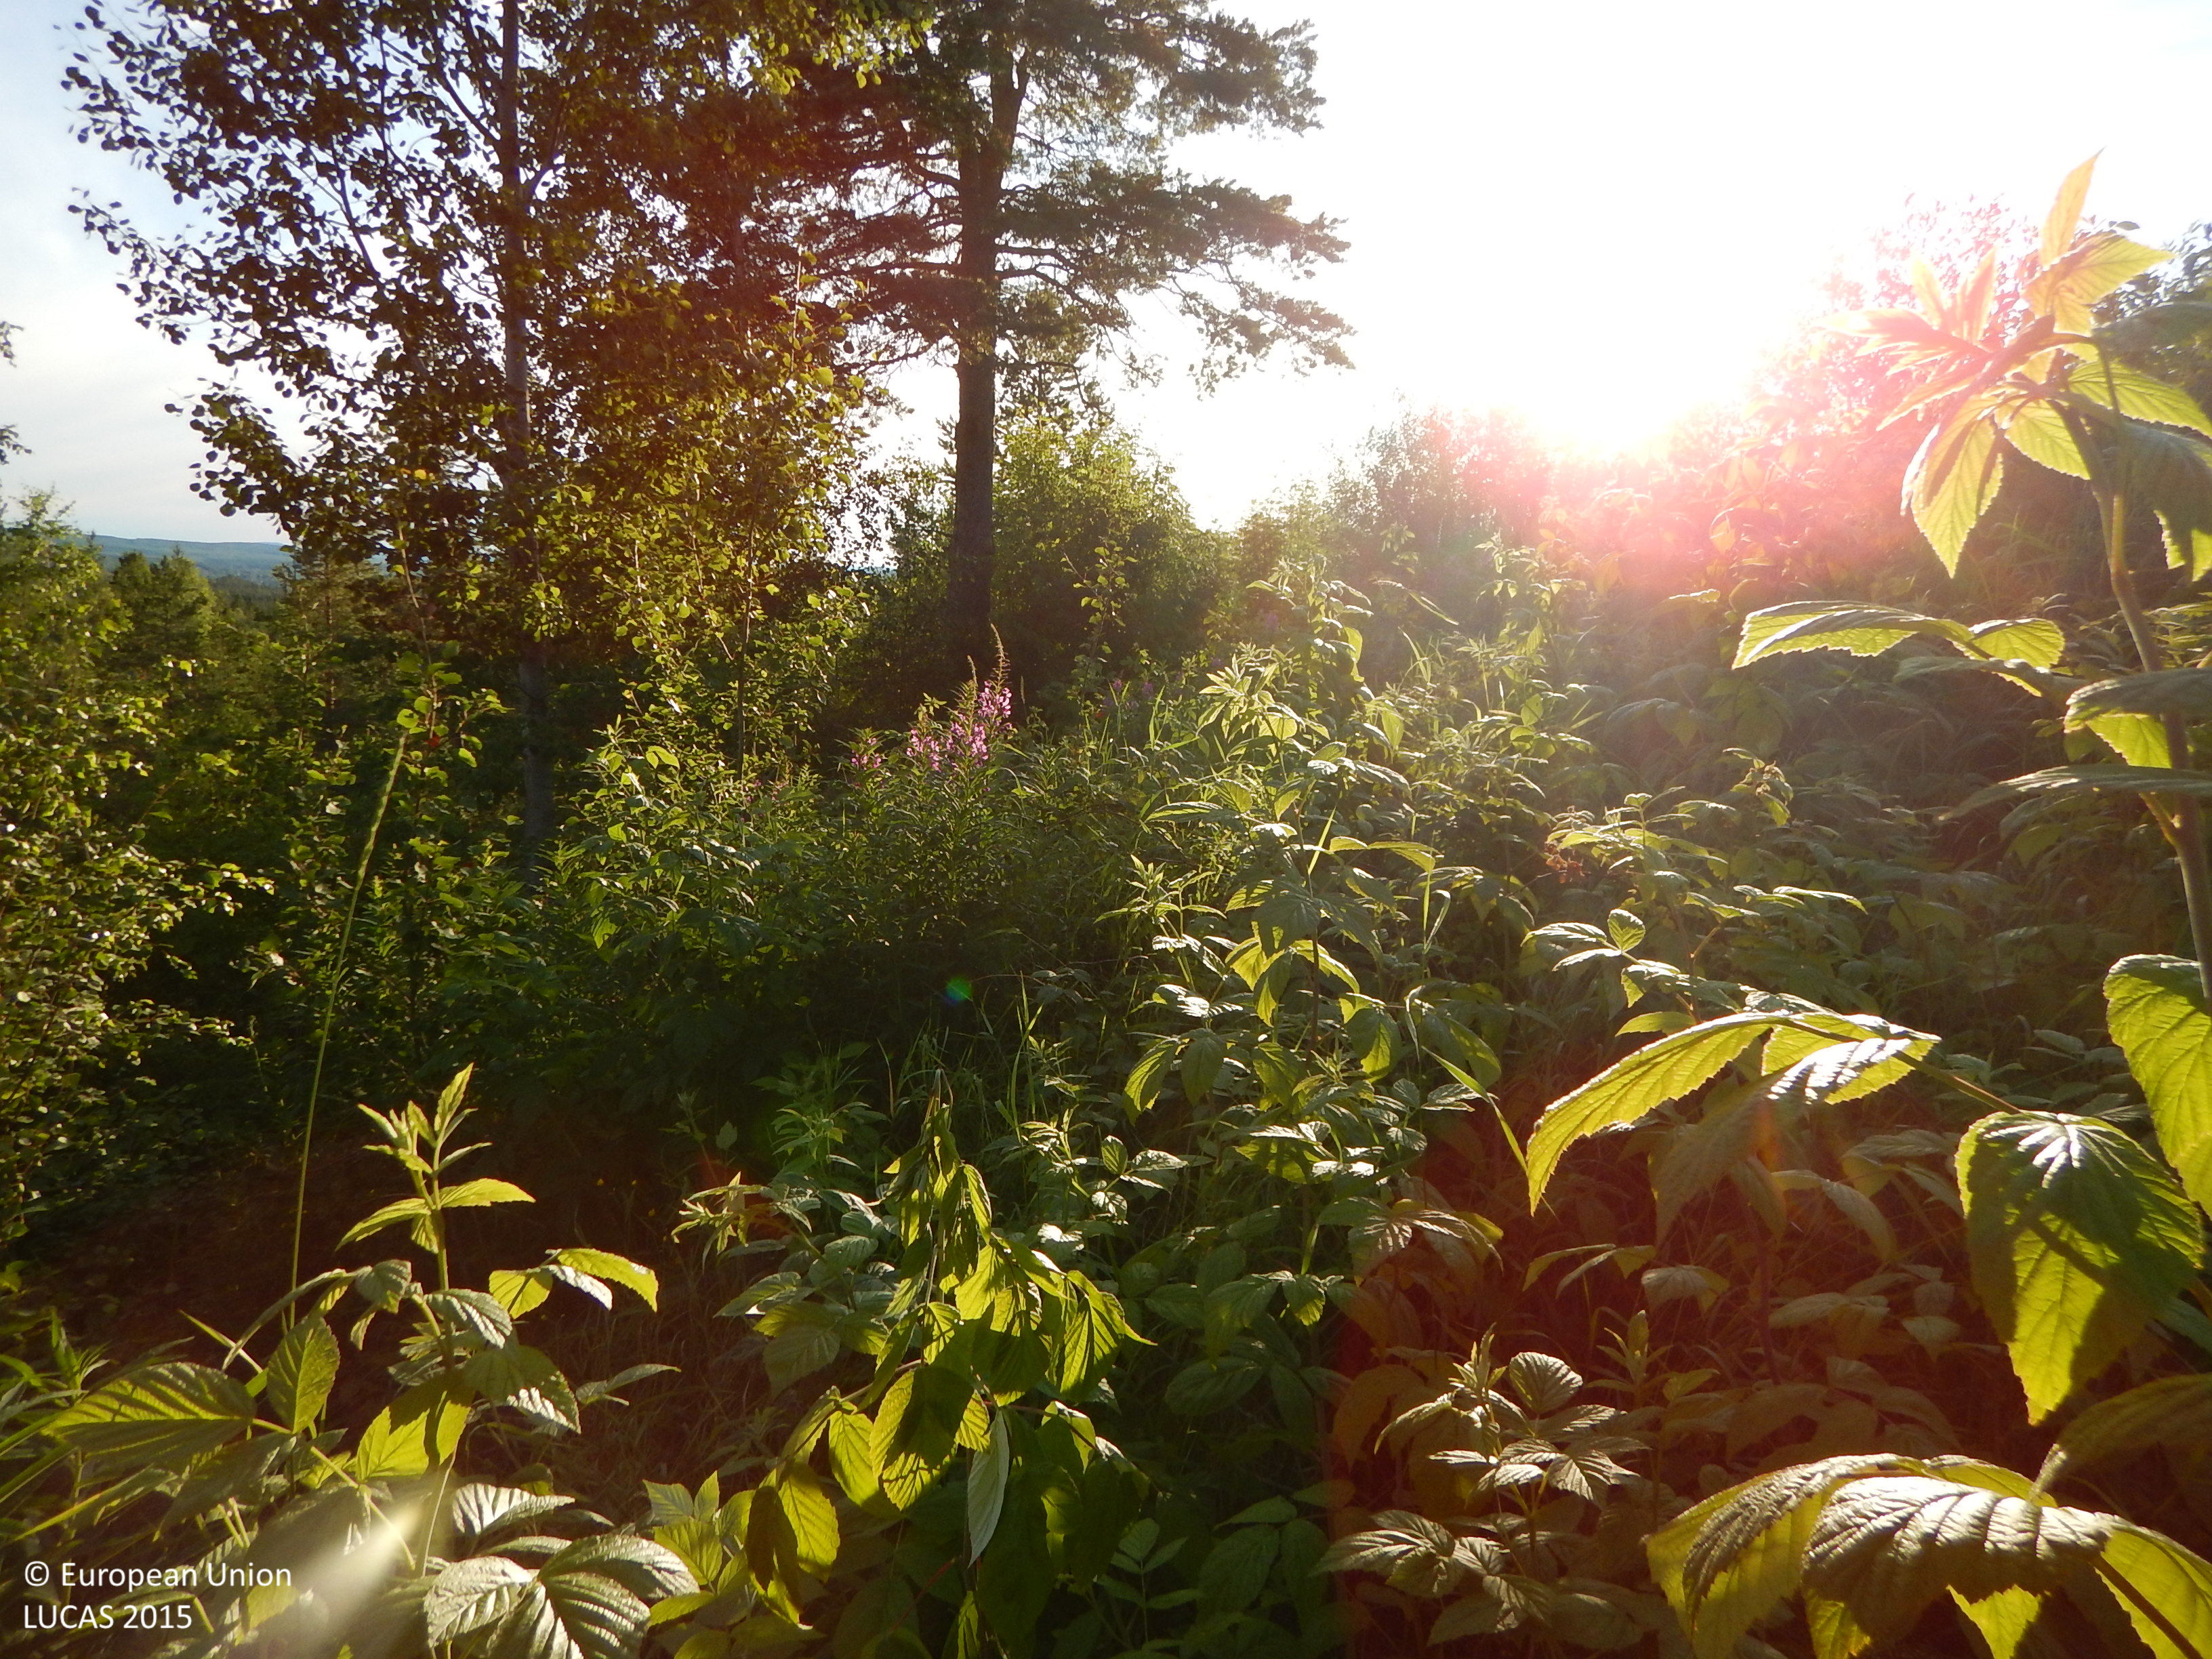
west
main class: Woodland
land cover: Broadleaved woodland
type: boreal forest
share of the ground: 50 - 75 %
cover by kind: broadleaved forest trees 50 %, shrubs 20 %, herbaceous plants 20 %, coniferous forest trees 10 %
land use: Semi-natural and natural areas not in use
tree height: > 5 m
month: July
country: SE
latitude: 64.7659
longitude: 20.9729
